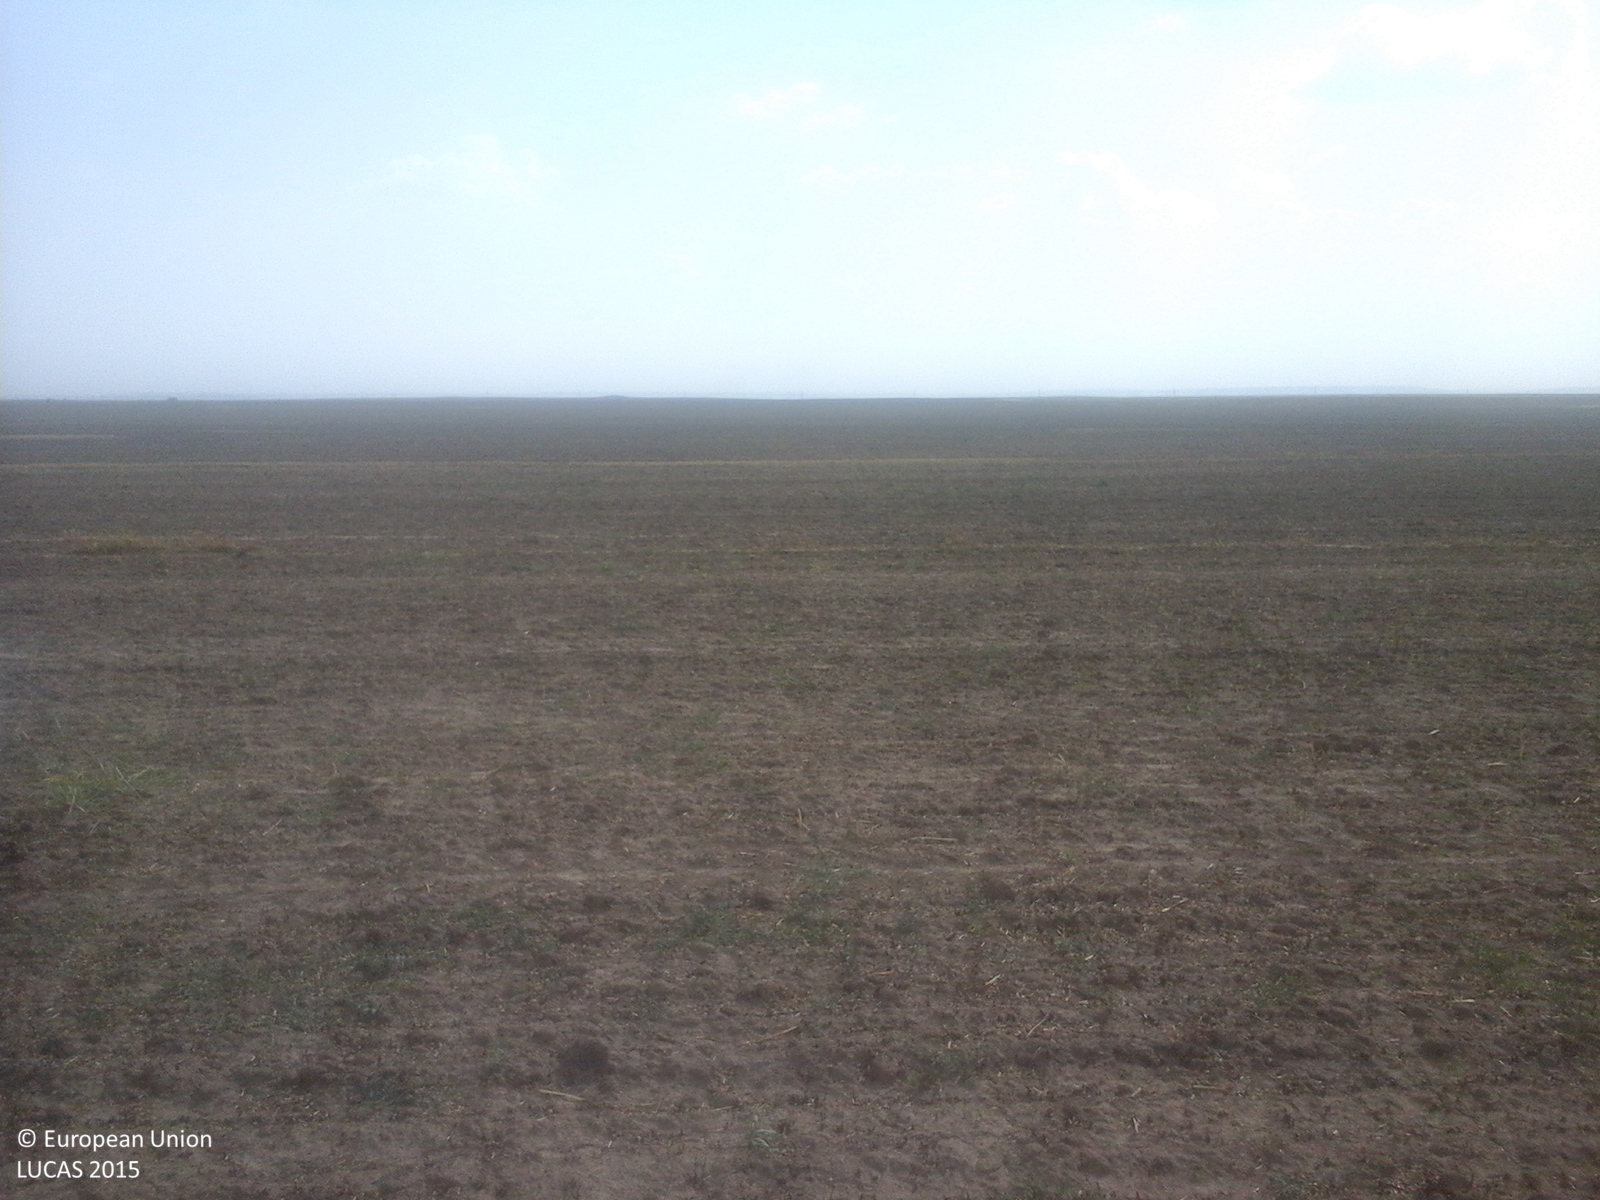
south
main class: Cropland
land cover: Common wheat
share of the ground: < 10 %
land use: Agriculture (excluding fallow land and kitchen gardens)
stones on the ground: < 10 %
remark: Burnt area
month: August
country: RO
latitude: 44.2888
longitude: 22.7601
